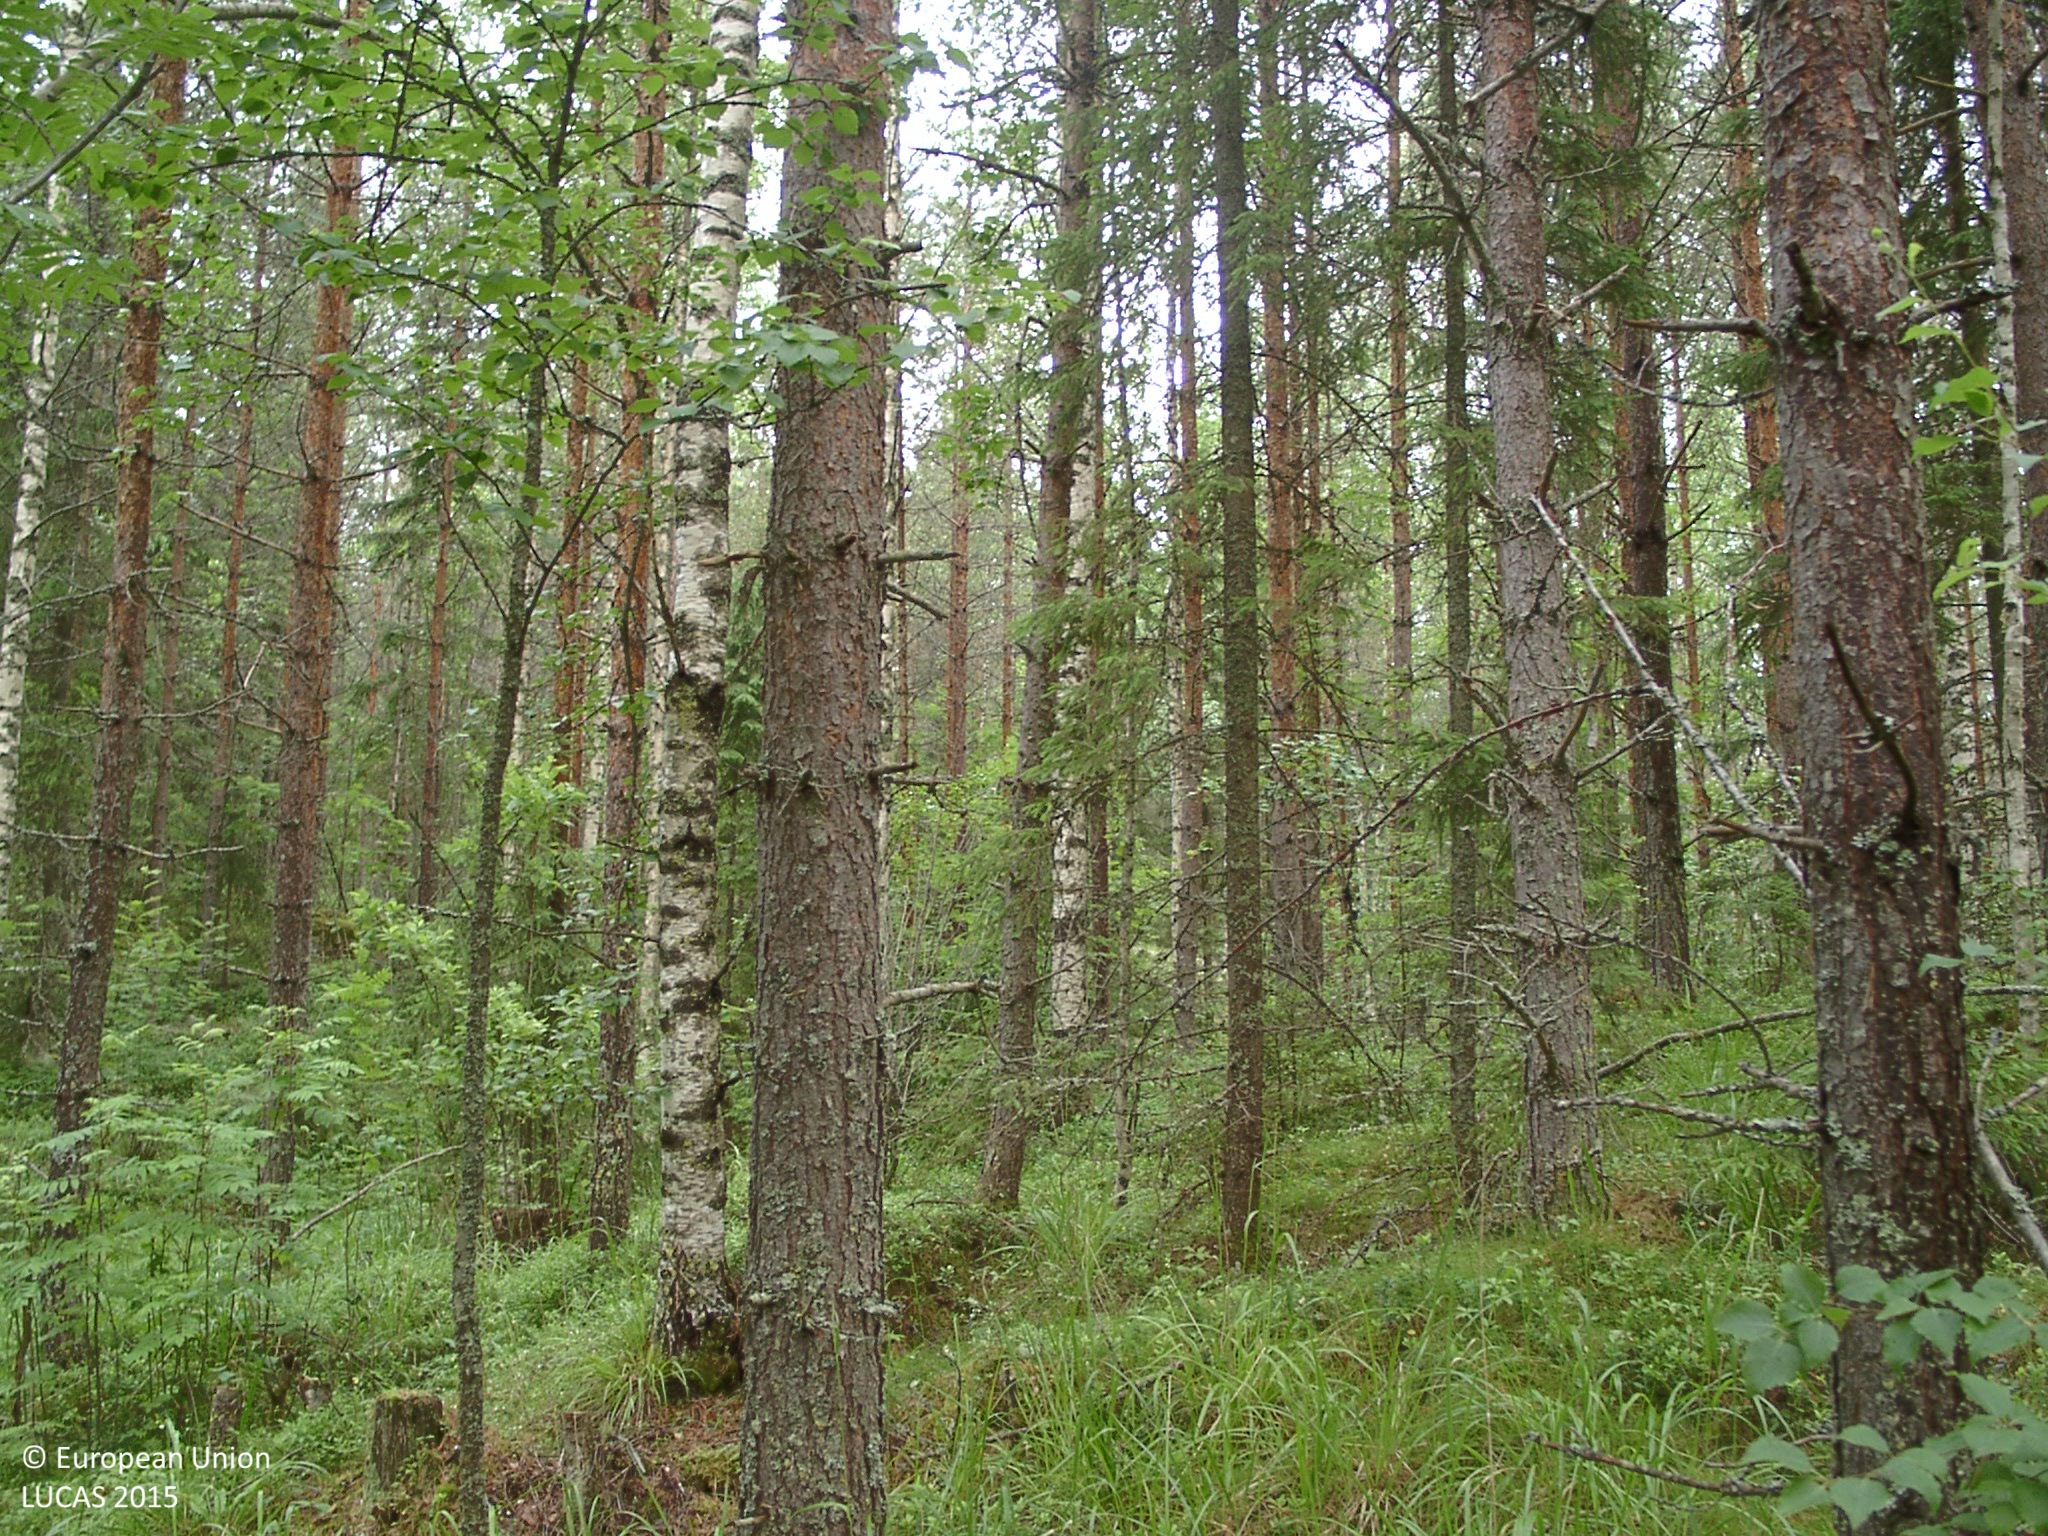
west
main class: Woodland
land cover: Pine dominated mixed woodland
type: boreal forest
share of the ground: 50 - 75 %
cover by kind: coniferous forest trees 45 %, broadleaved forest trees 25 %, shrubs 15 %, herbaceous plants 15 %
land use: Forestry
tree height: > 5 m
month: July
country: FI
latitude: 62.1134
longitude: 25.3481
